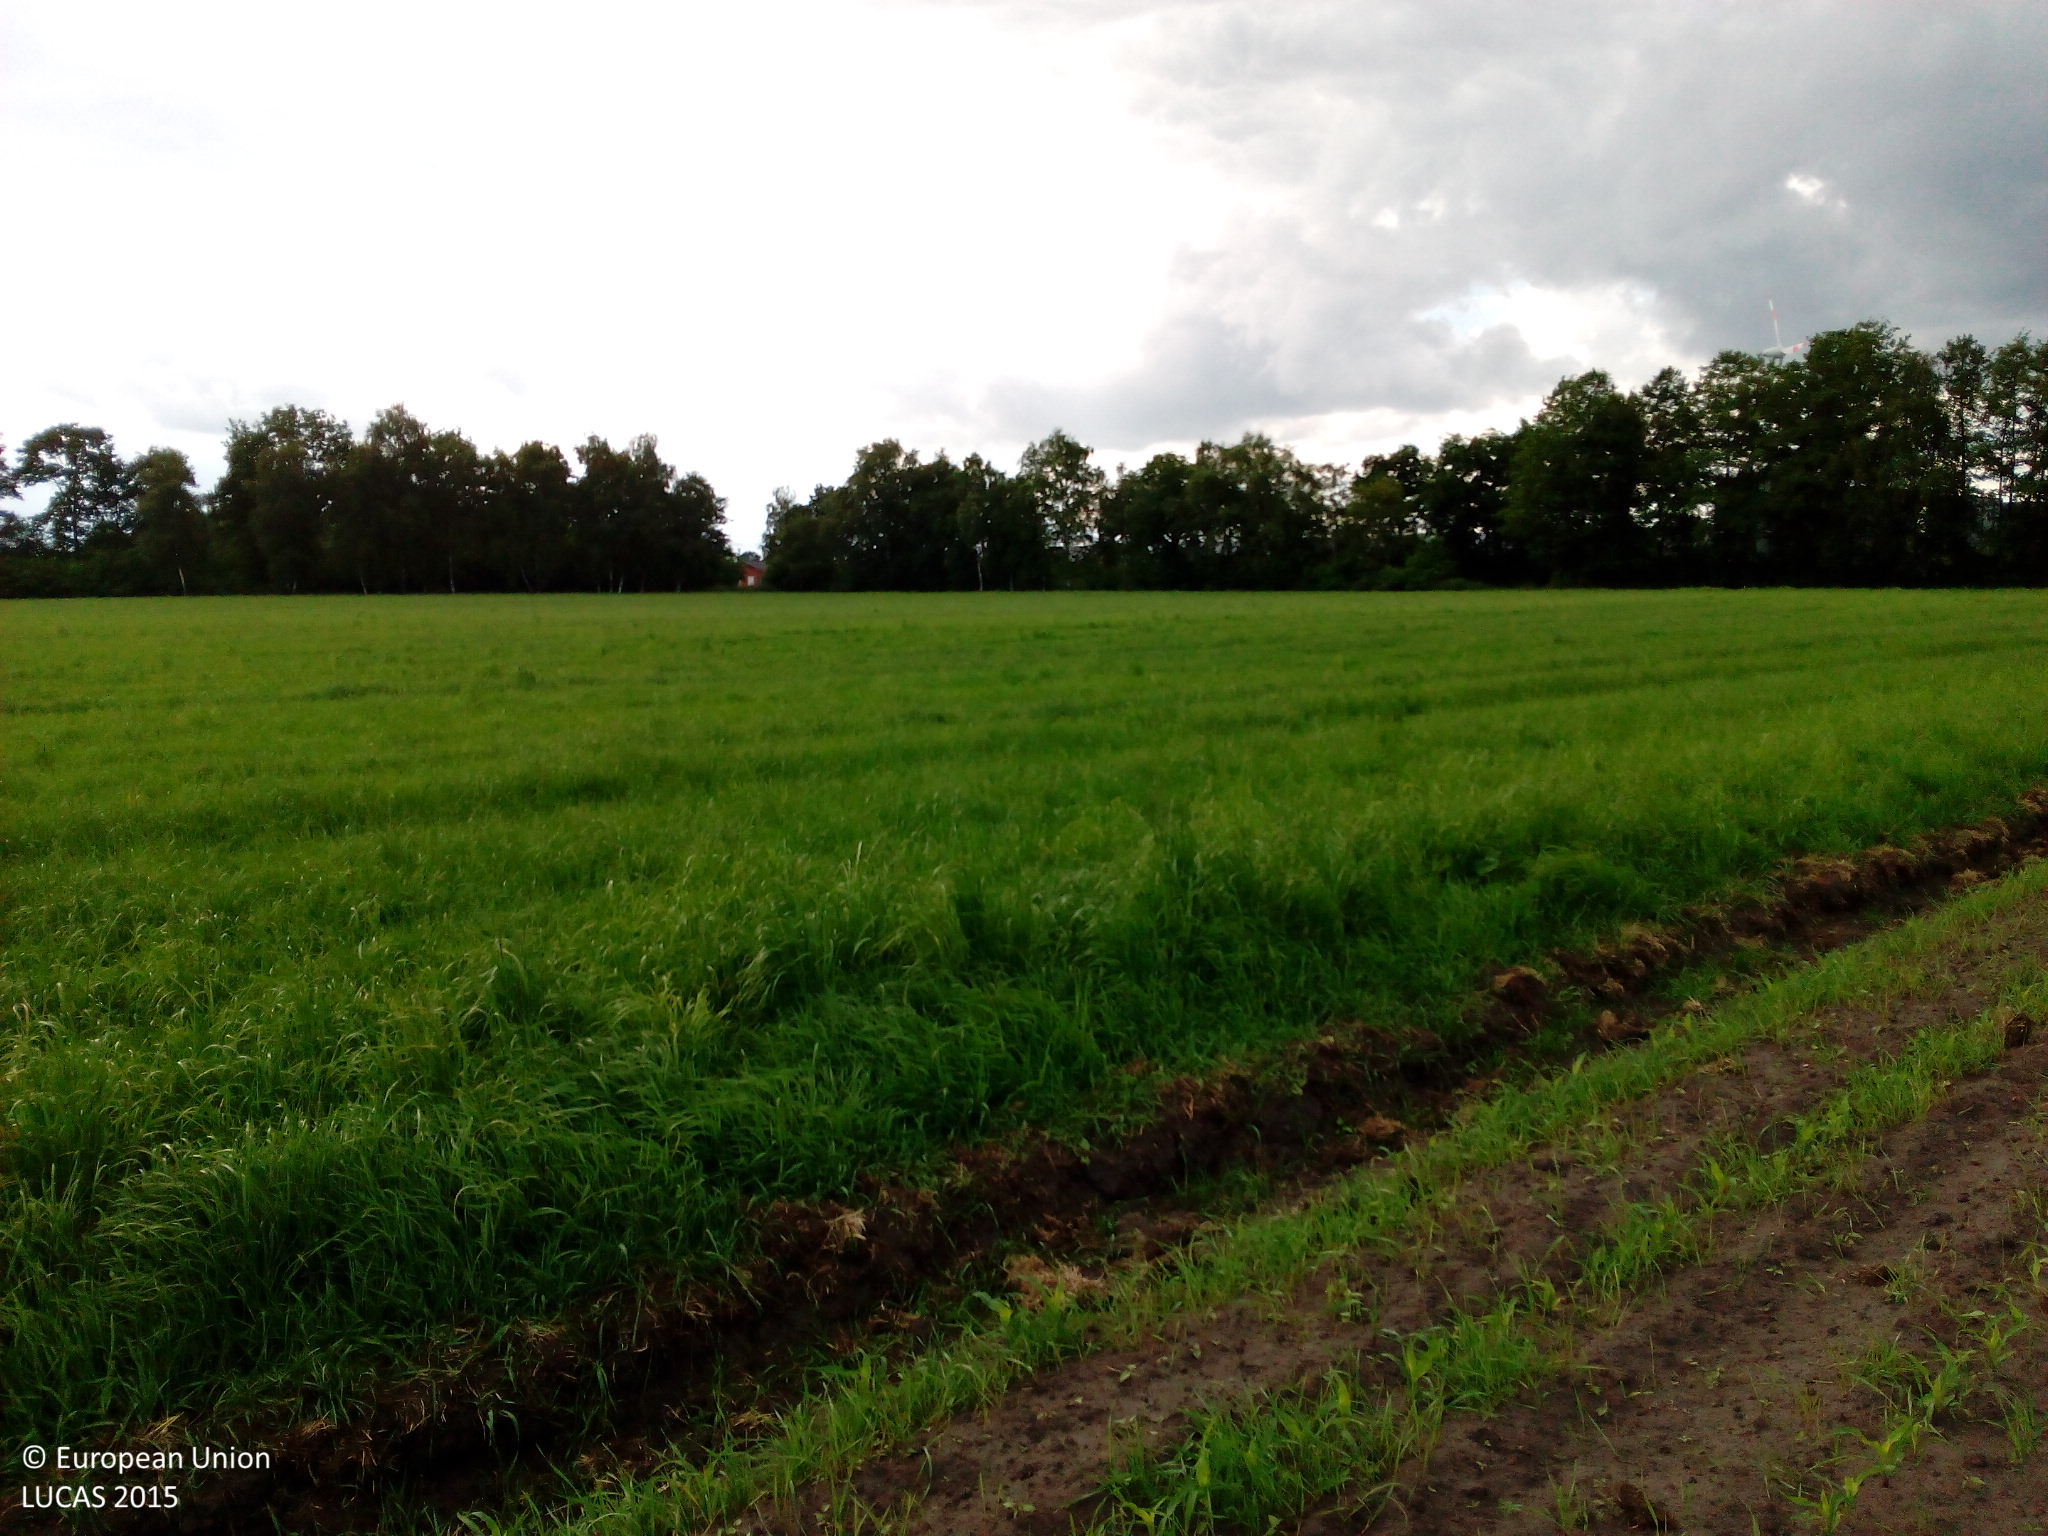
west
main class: Cropland
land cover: Maize
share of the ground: > 75 %
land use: Agriculture (excluding fallow land and kitchen gardens)
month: June
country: DE
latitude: 52.6358
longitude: 7.3554
